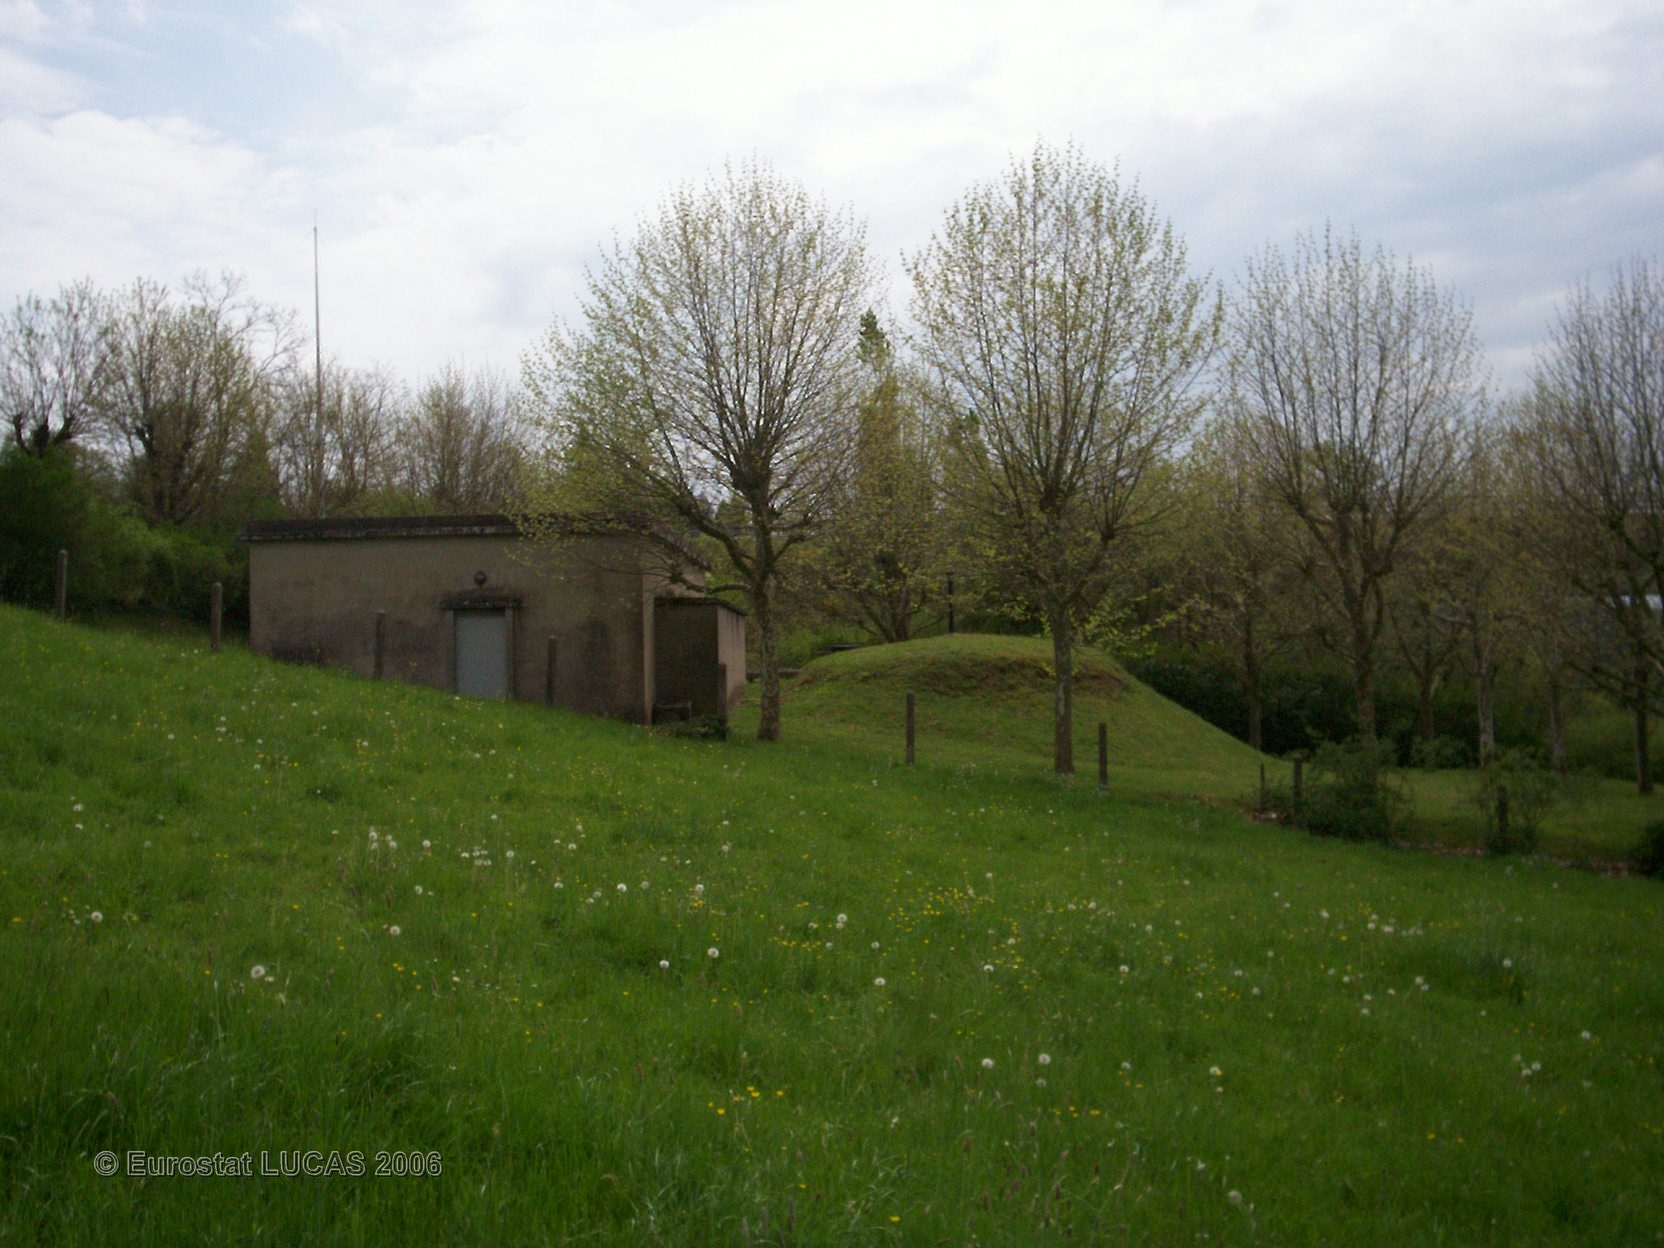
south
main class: Grassland
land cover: Grassland without tree/shrub cover
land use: Agriculture (excluding fallow land and kitchen gardens)
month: May
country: FR
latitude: 45.8821
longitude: 4.1136
